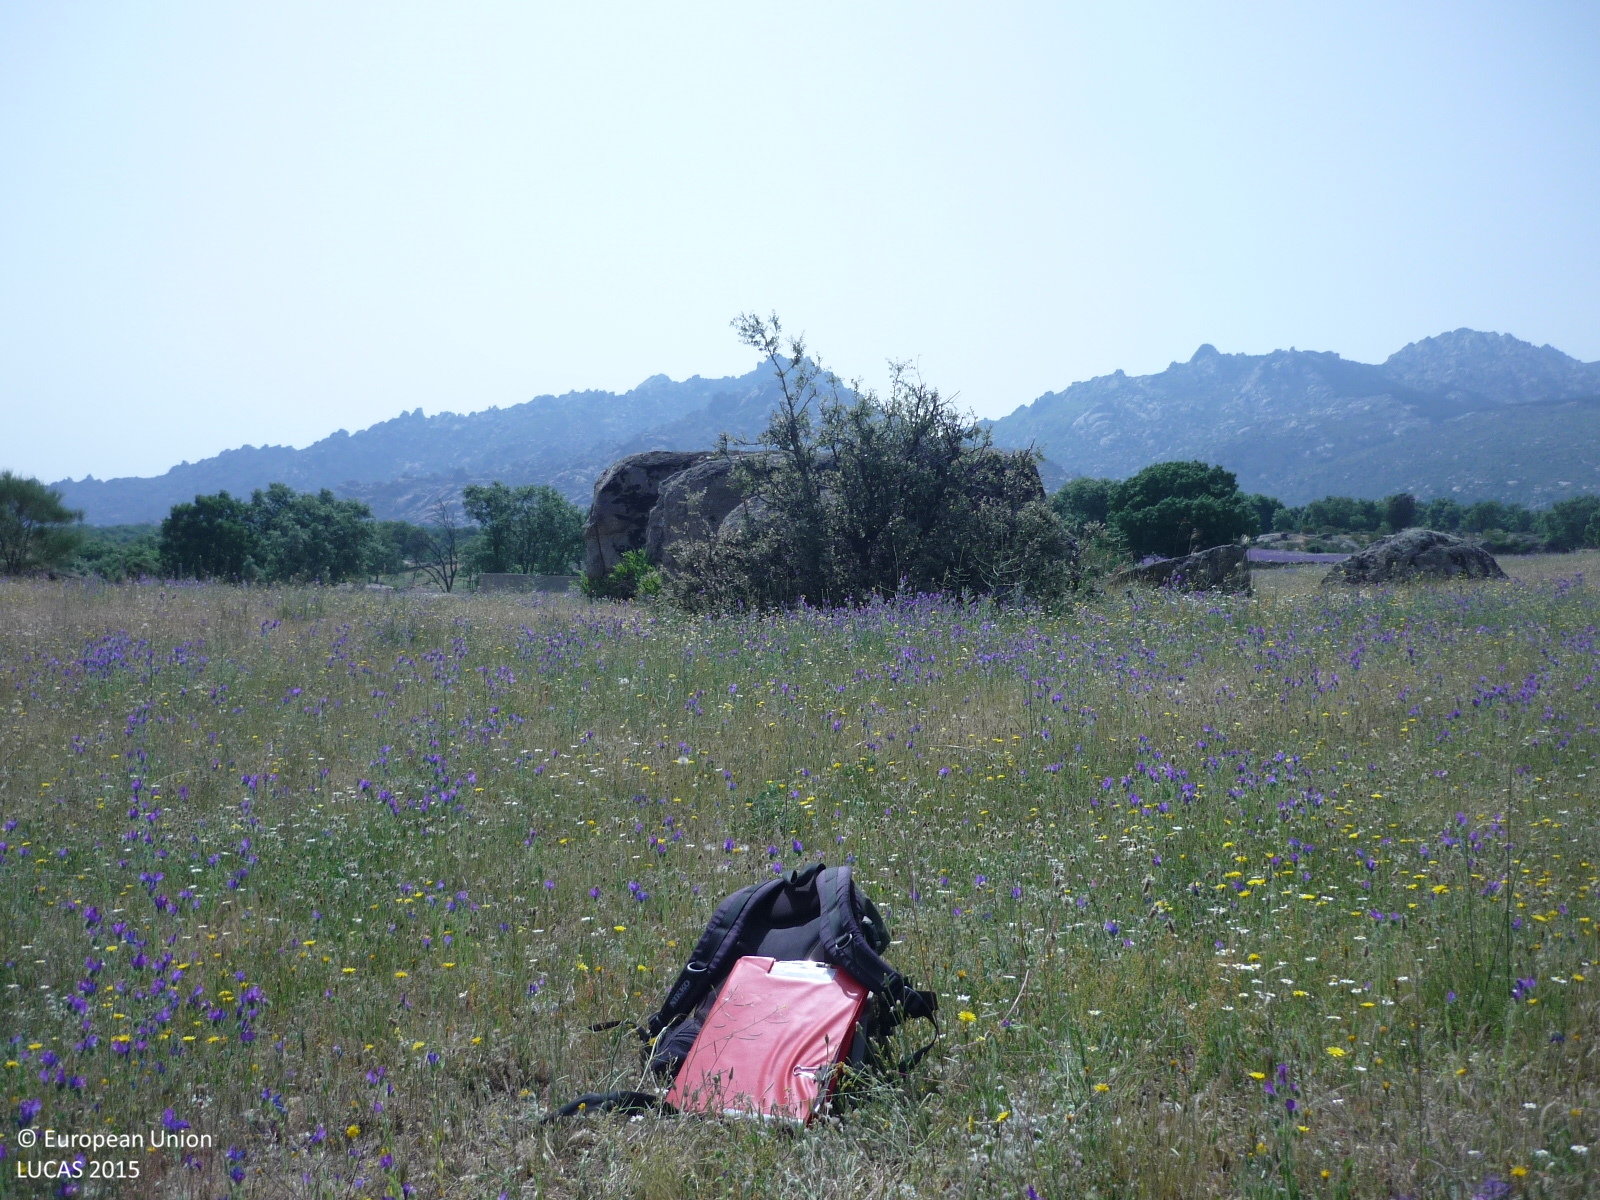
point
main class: Grassland
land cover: Grassland with sparse tree/shrub cover
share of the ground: > 75 %
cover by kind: herbaceous plants 85 %, shrubs 10 %, broadleaved forest trees 5 %
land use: Agriculture (excluding fallow land and kitchen gardens)
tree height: < 5 m
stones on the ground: < 10 %
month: May
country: ES
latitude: 40.7711
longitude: -3.7984
